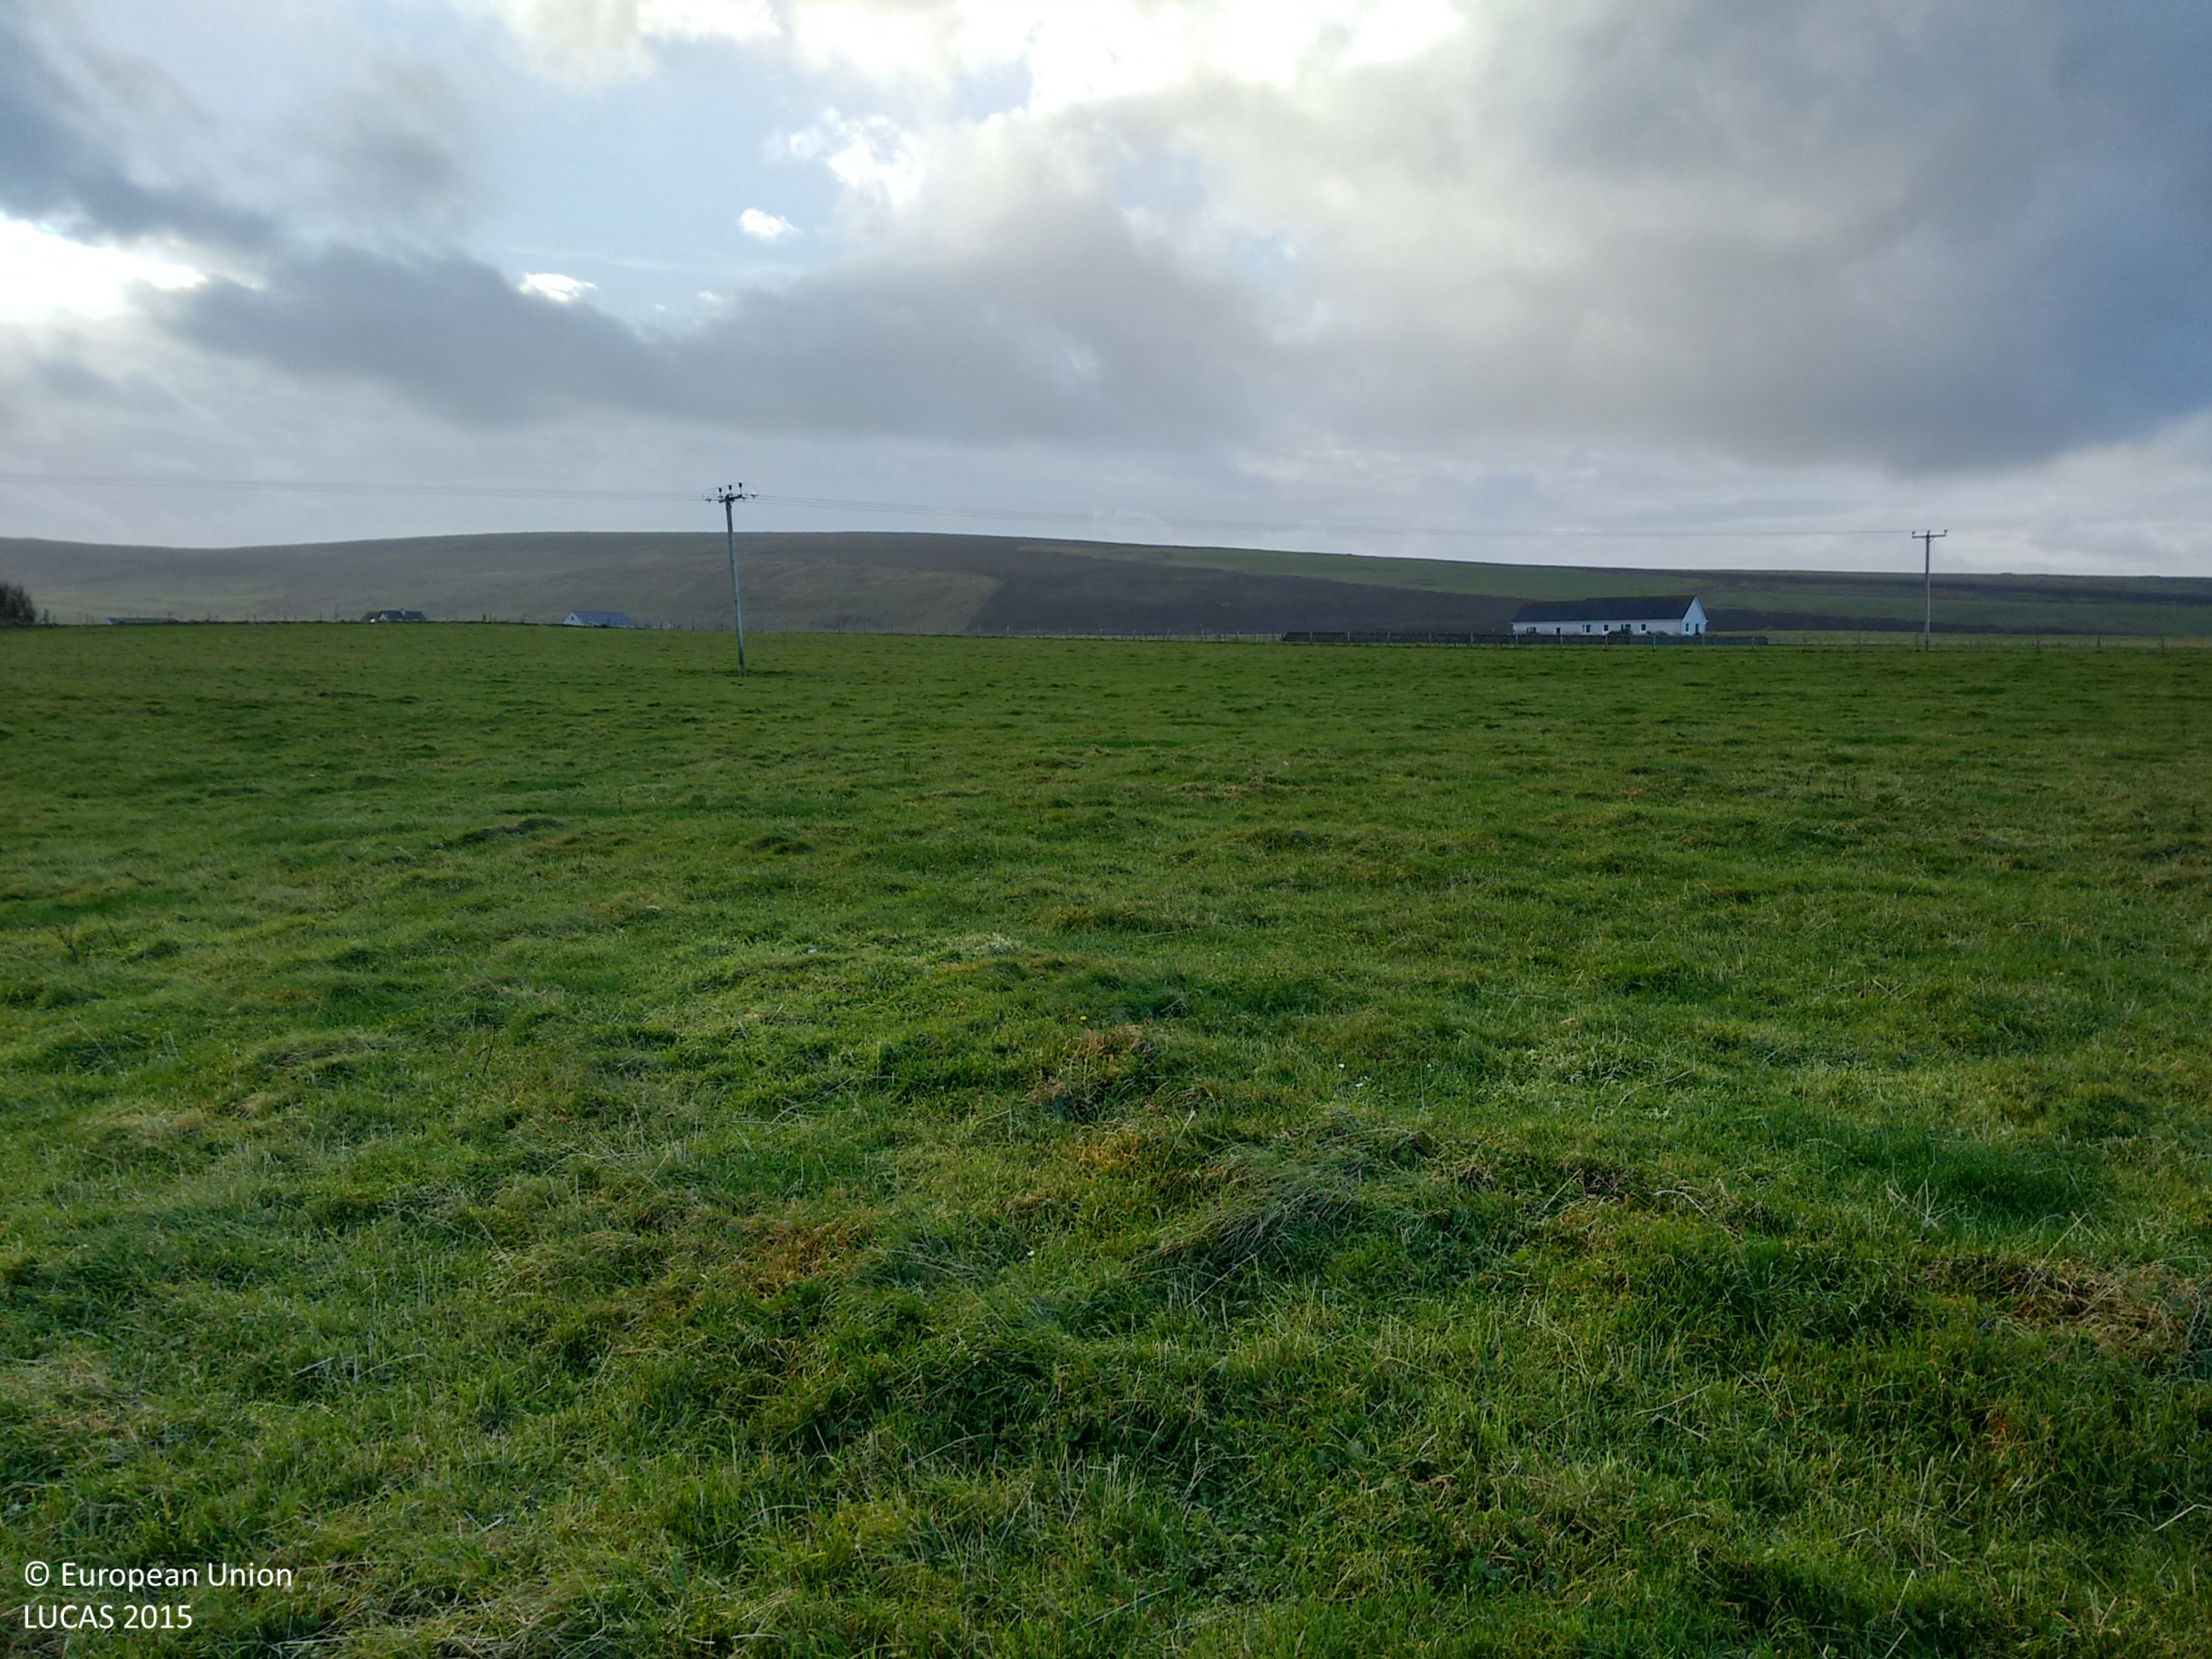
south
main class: Grassland
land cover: Grassland without tree/shrub cover
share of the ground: > 75 %
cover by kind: herbaceous plants 100 %
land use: Agriculture (excluding fallow land and kitchen gardens)
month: November
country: GB
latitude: 58.9903
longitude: -3.1948
